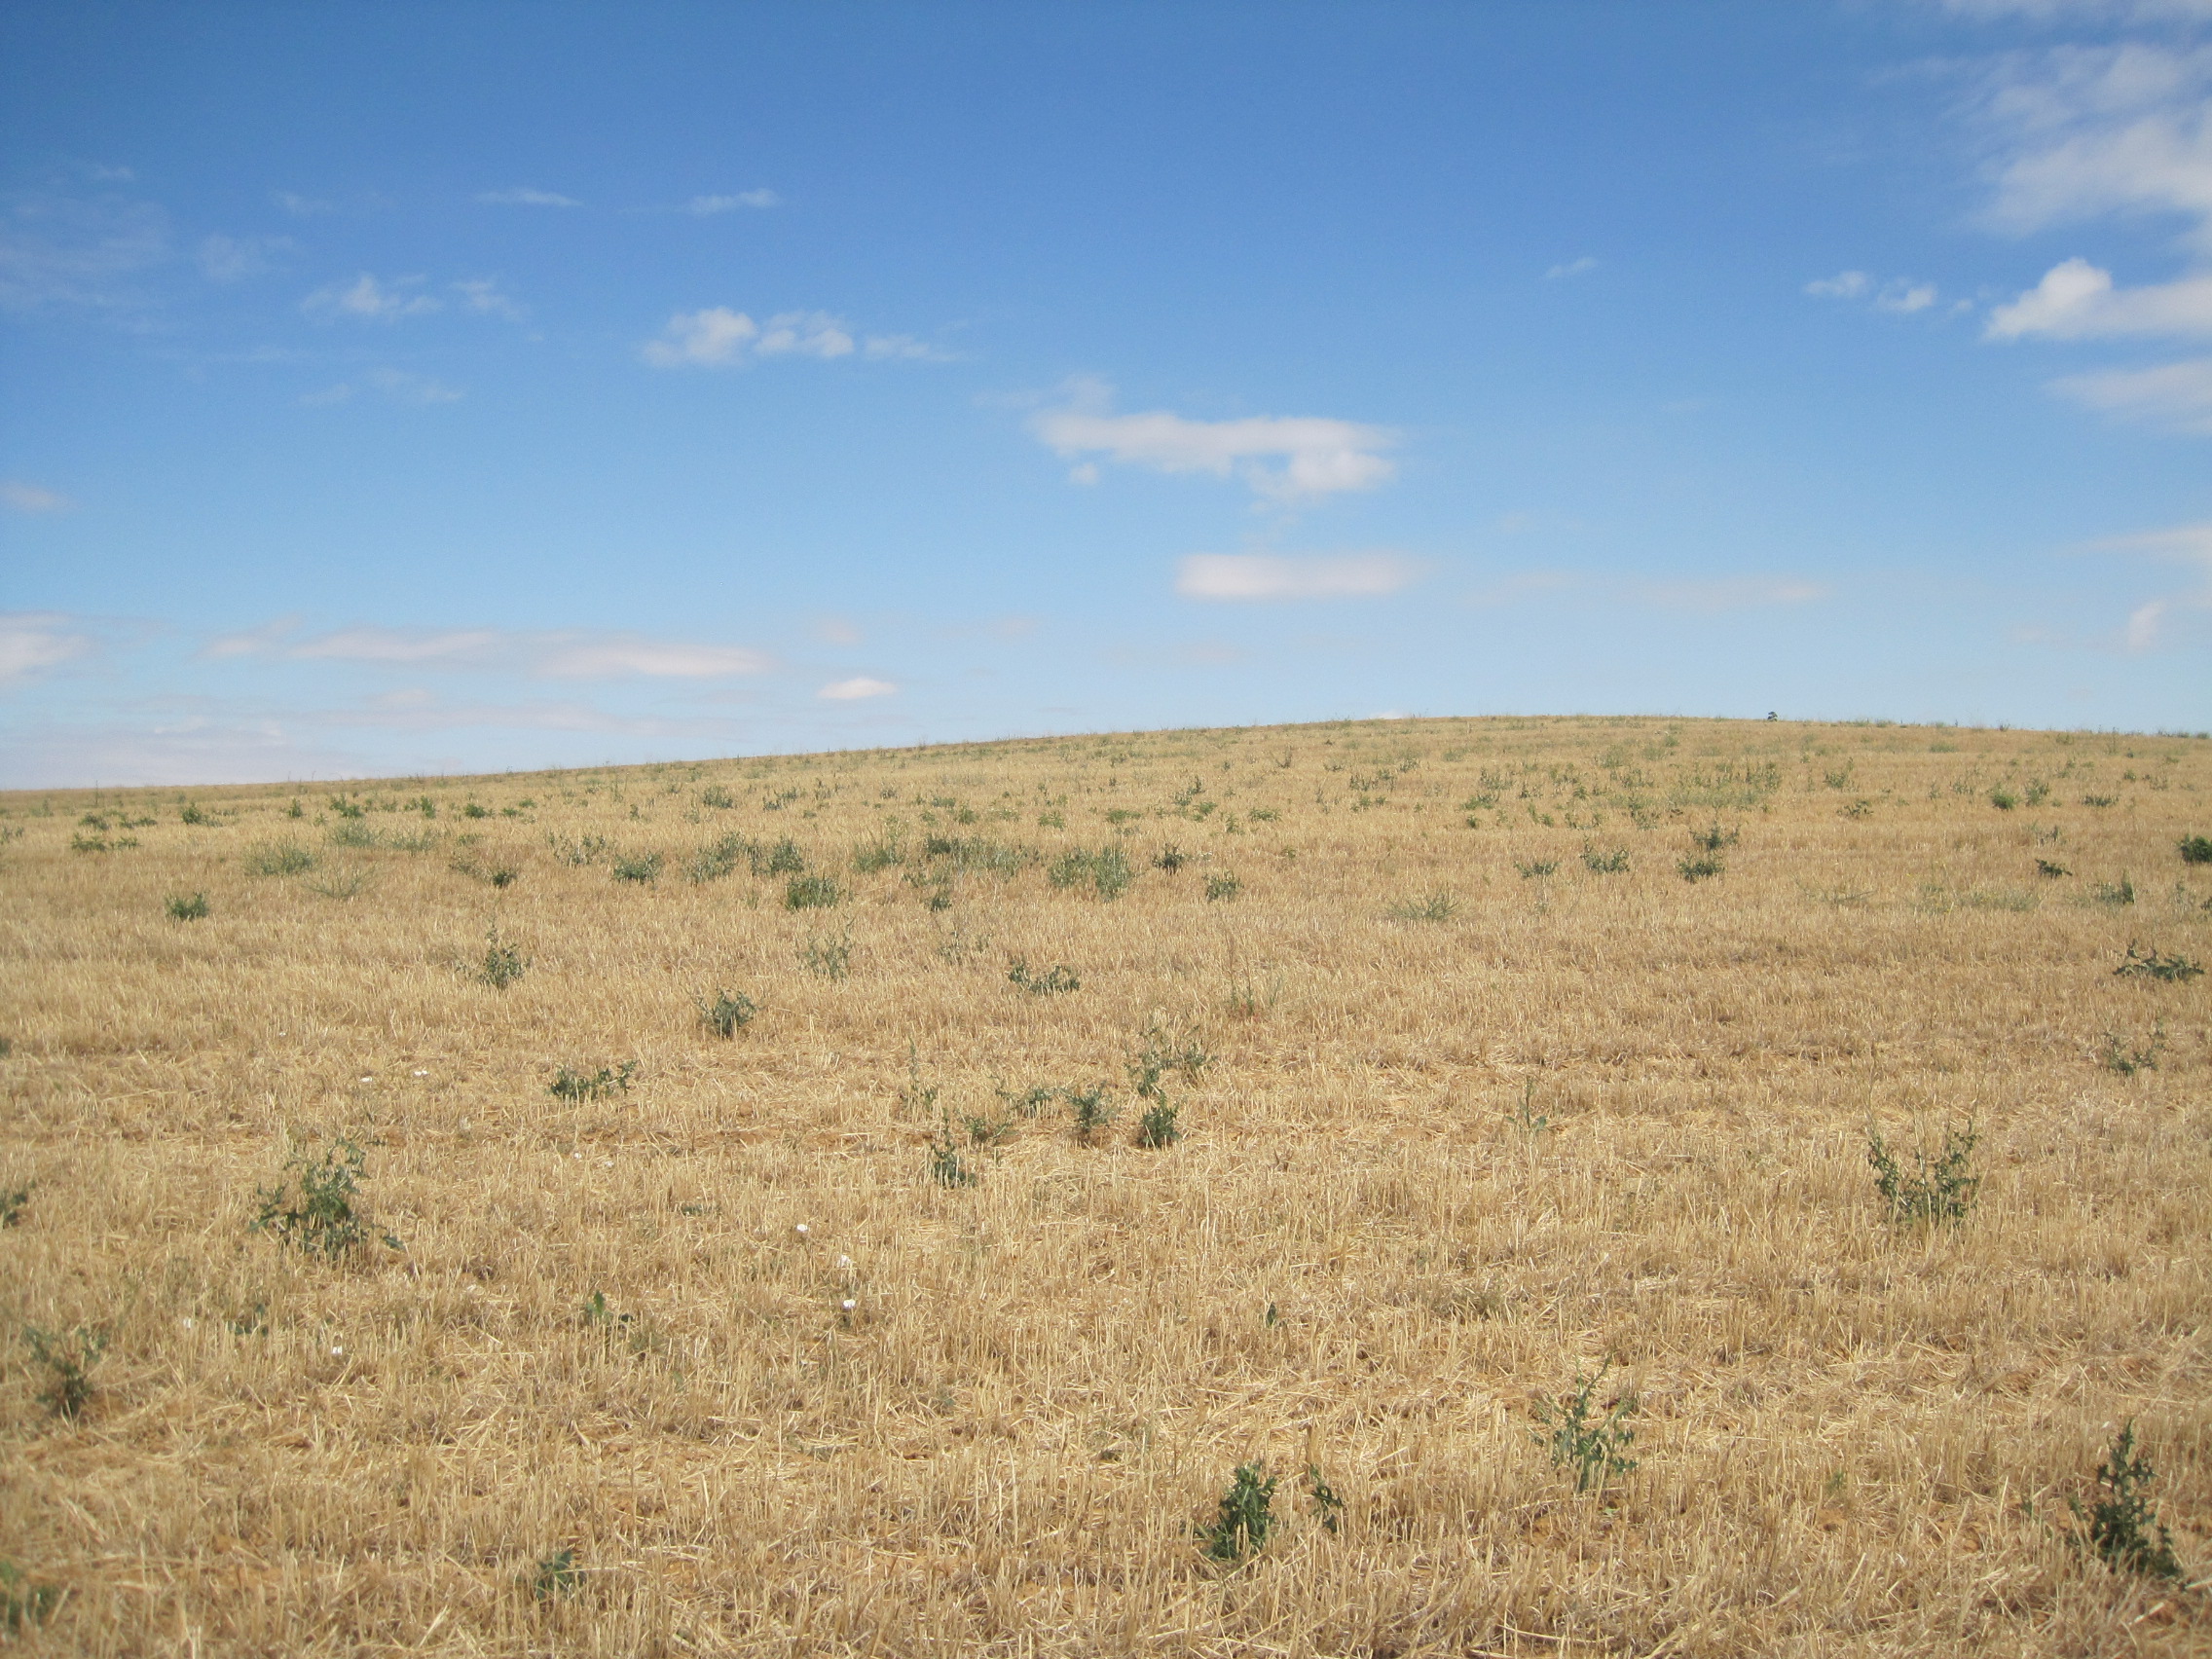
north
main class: Cropland
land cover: Barley
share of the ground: < 10 %
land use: Agriculture (excluding fallow land and kitchen gardens)
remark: Harvested field
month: July
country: ES
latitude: 42.0285
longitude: -5.2169
